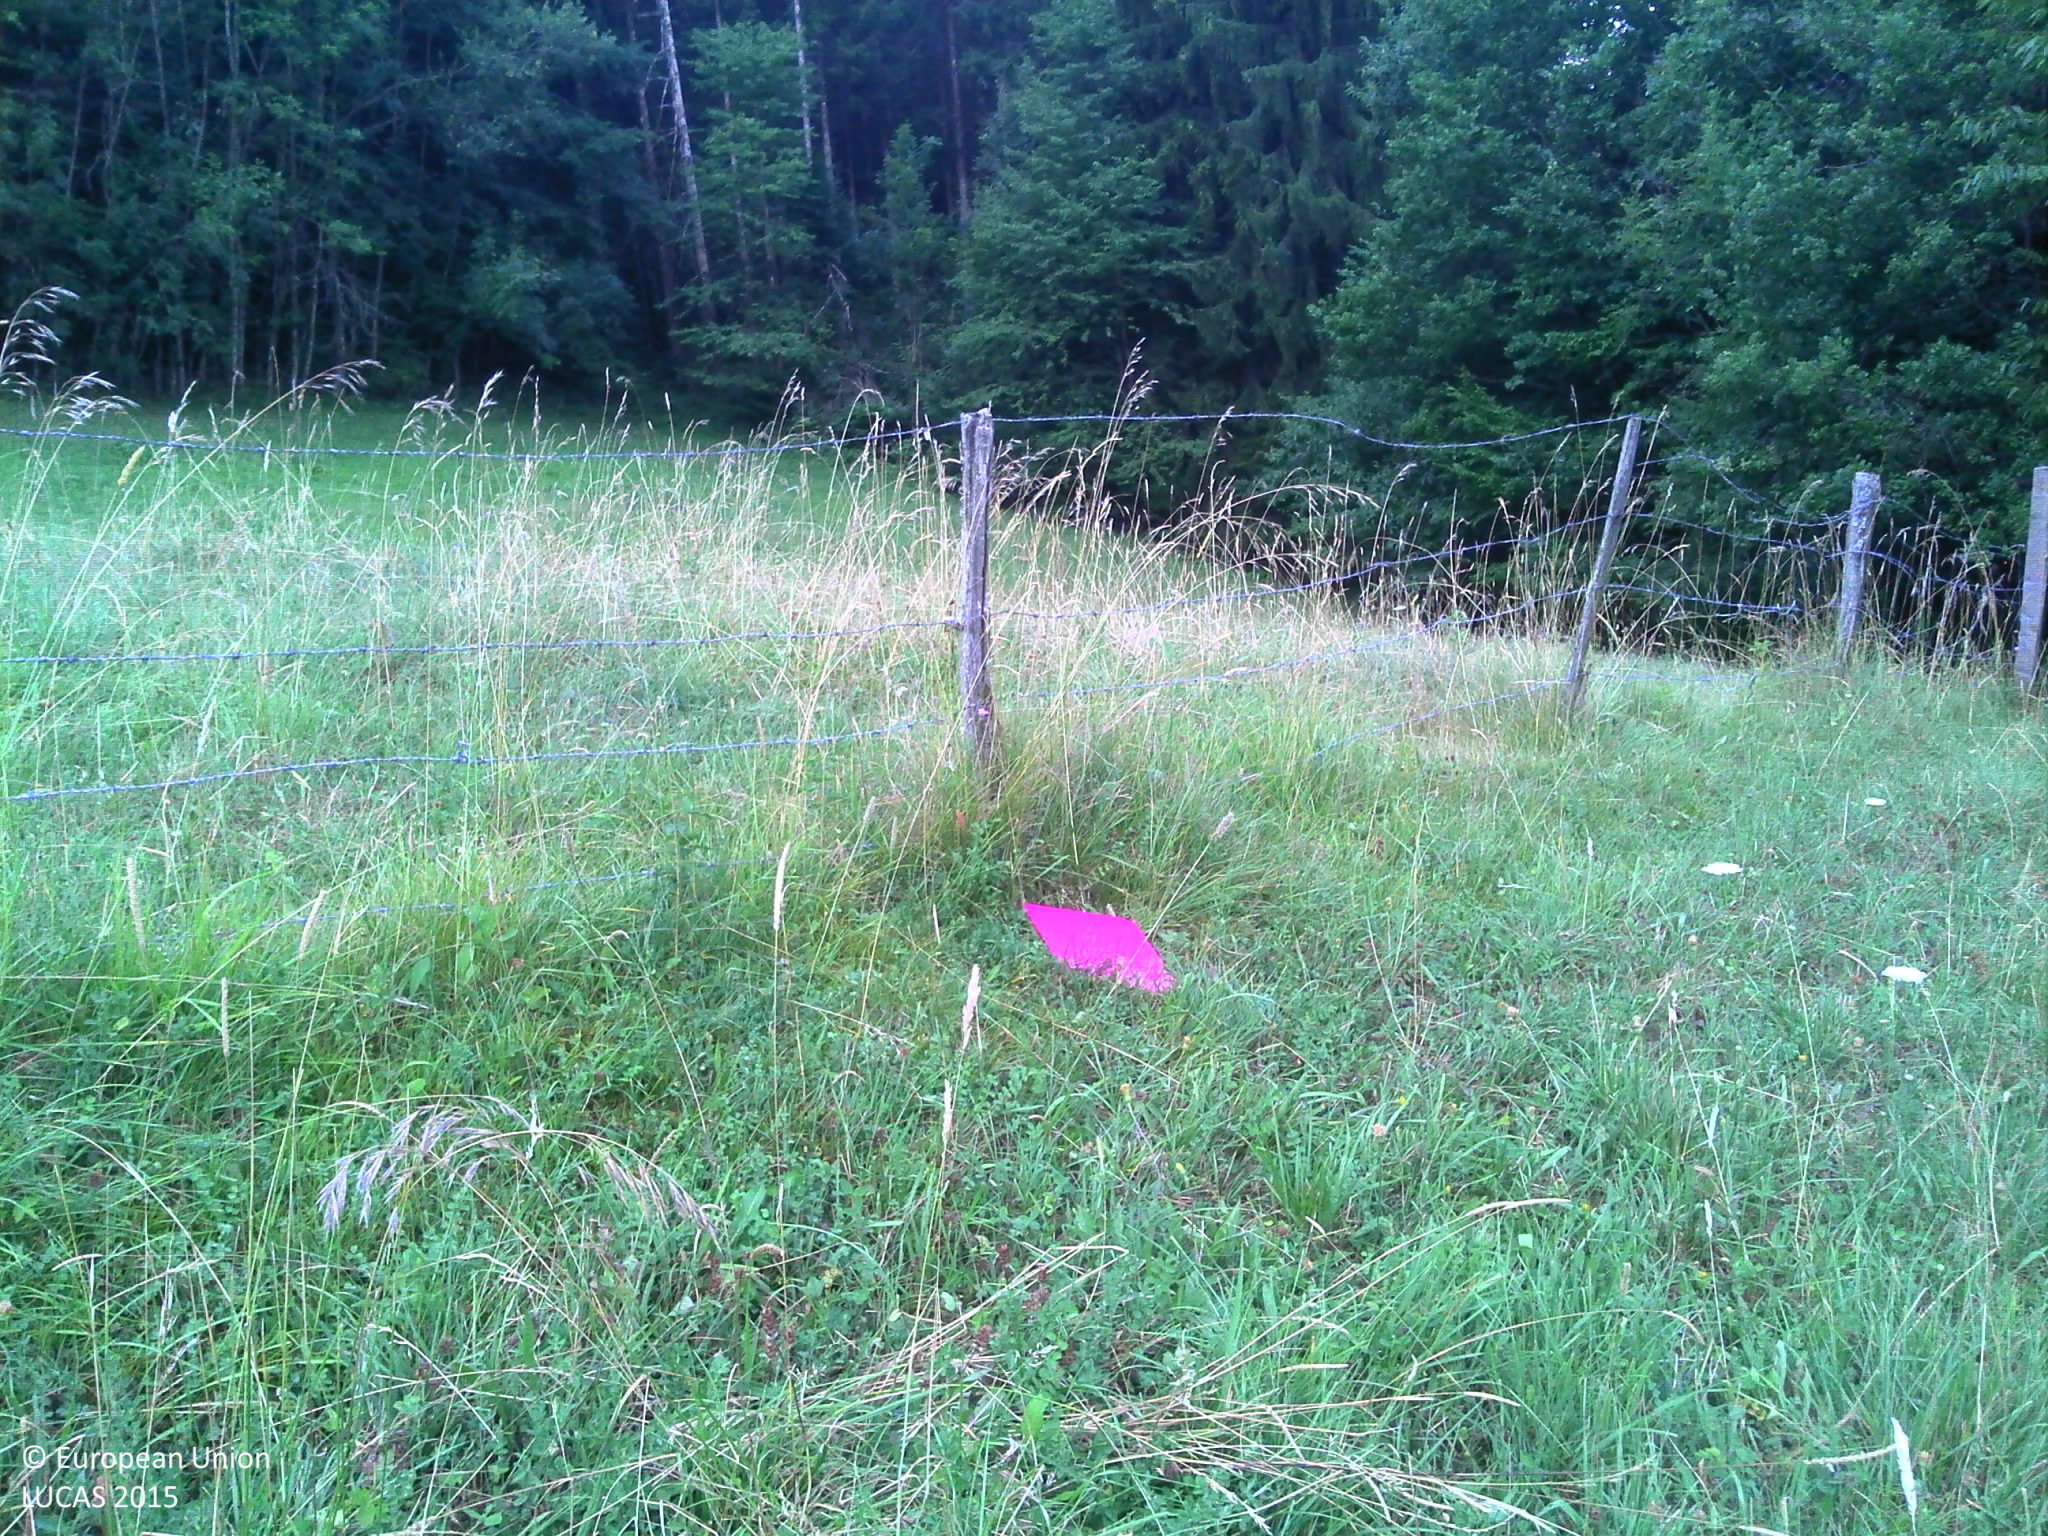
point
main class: Grassland
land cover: Grassland without tree/shrub cover
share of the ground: > 75 %
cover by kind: herbaceous plants 100 %
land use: Agriculture (excluding fallow land and kitchen gardens)
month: July
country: FR
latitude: 45.9231
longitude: 6.2000
